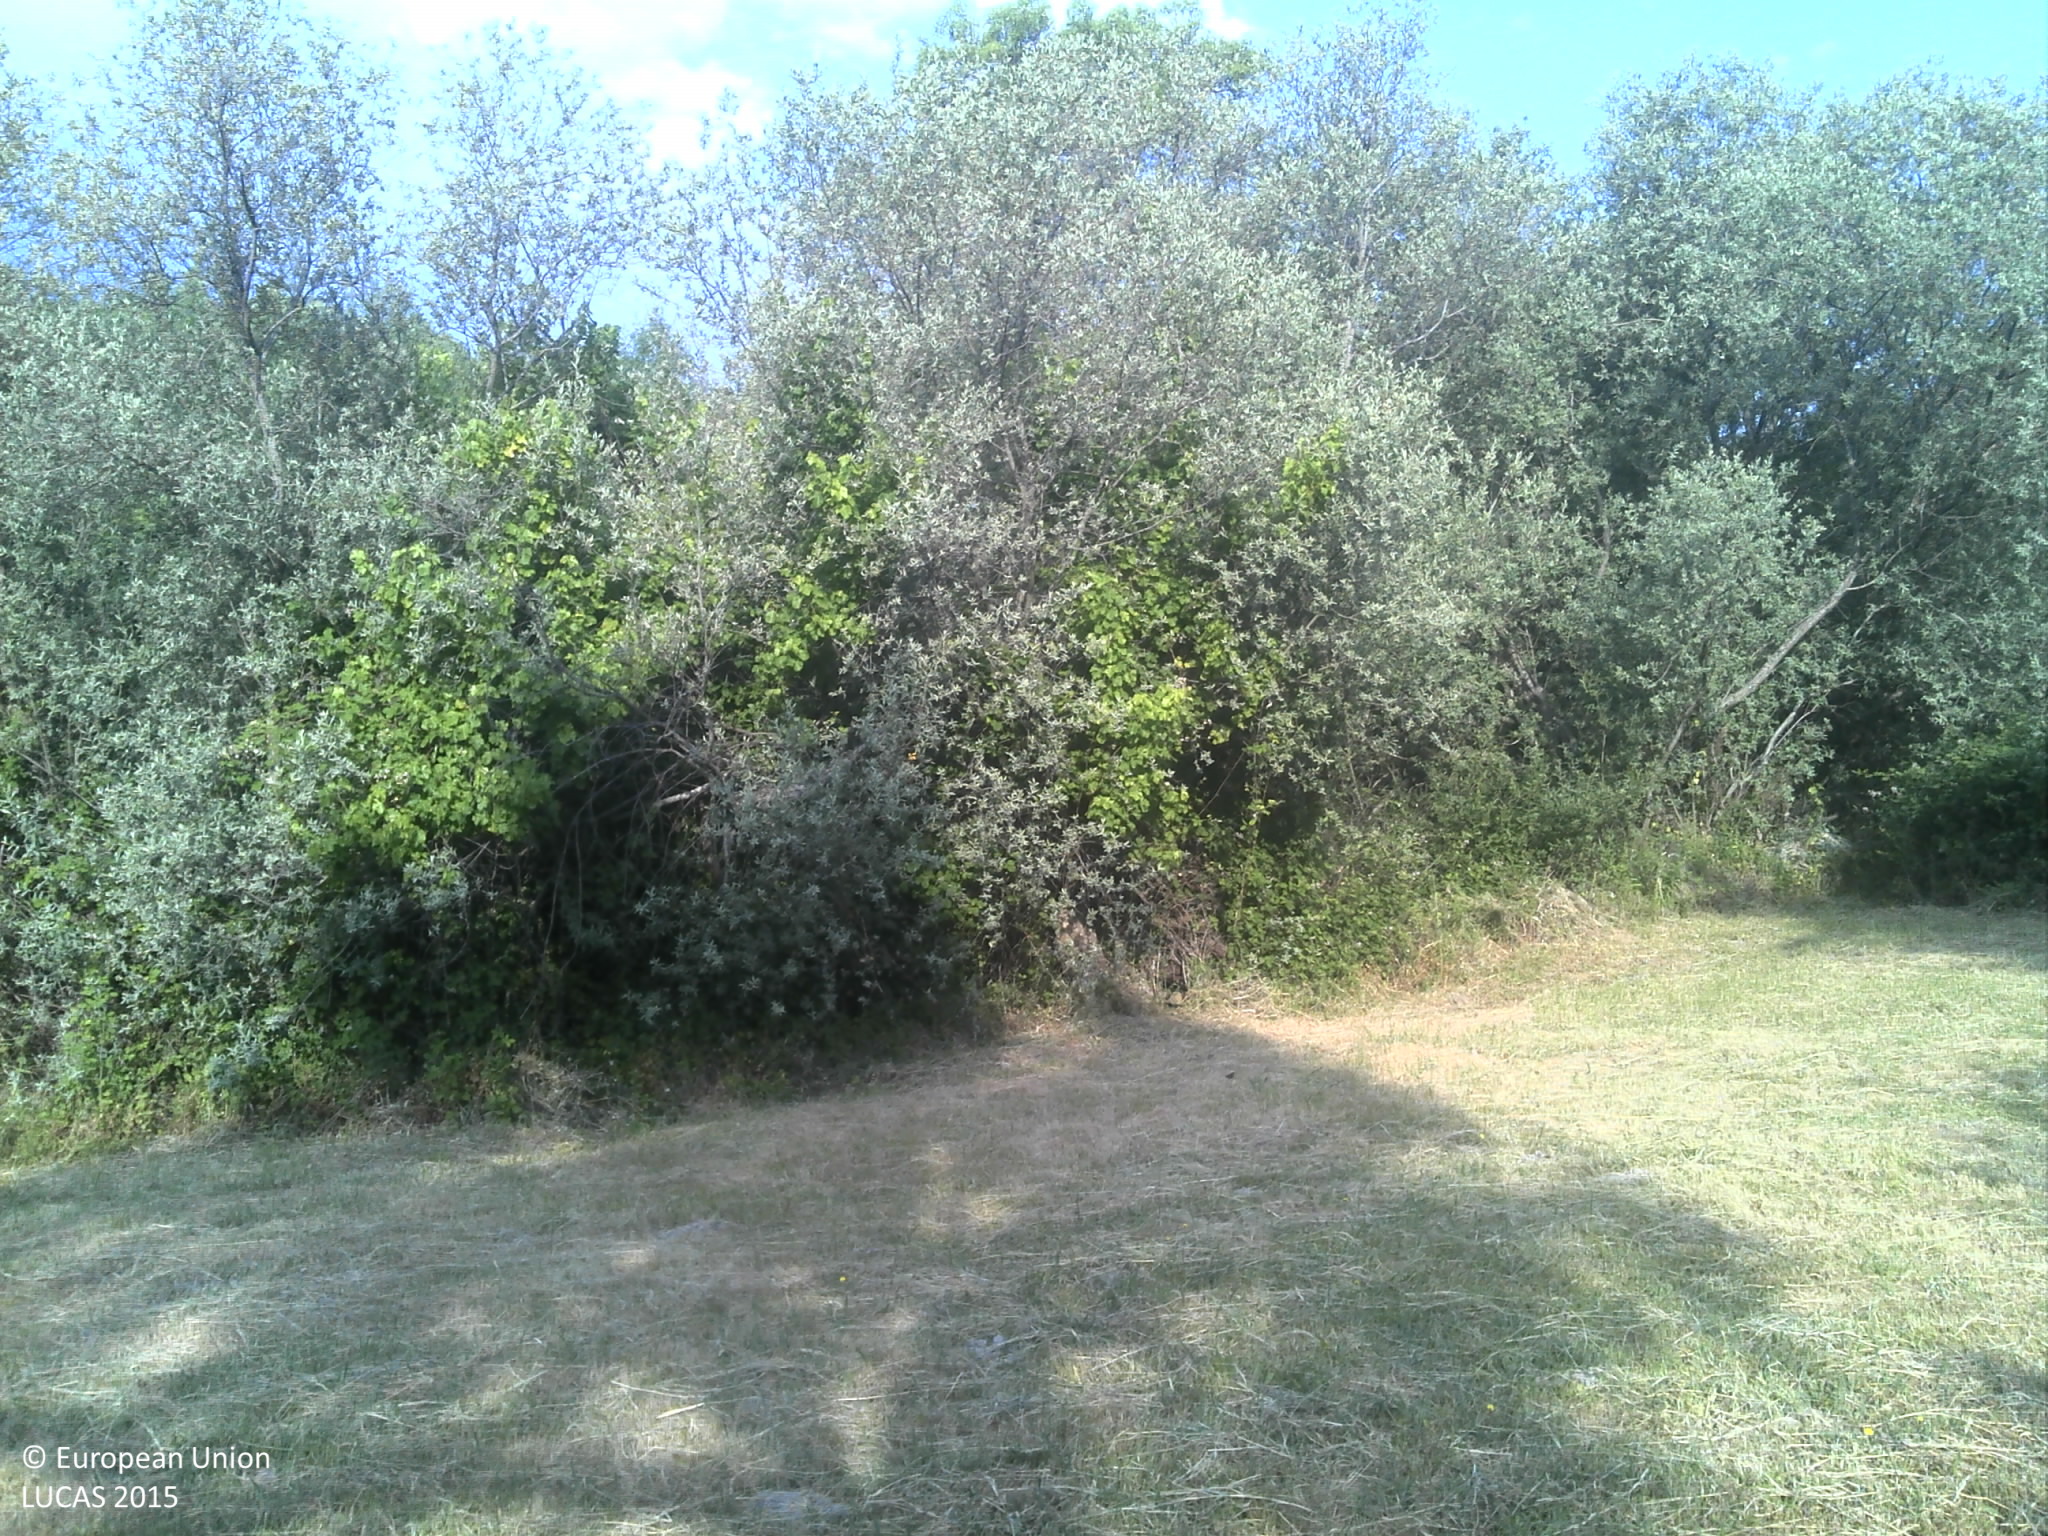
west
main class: Grassland
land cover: Grassland without tree/shrub cover
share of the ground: 50 - 75 %
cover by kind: herbaceous plants 55 %, unconsolidated bare surface 45 %
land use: Agriculture (excluding fallow land and kitchen gardens)
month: June
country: PT
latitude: 40.3568
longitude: -7.2102
